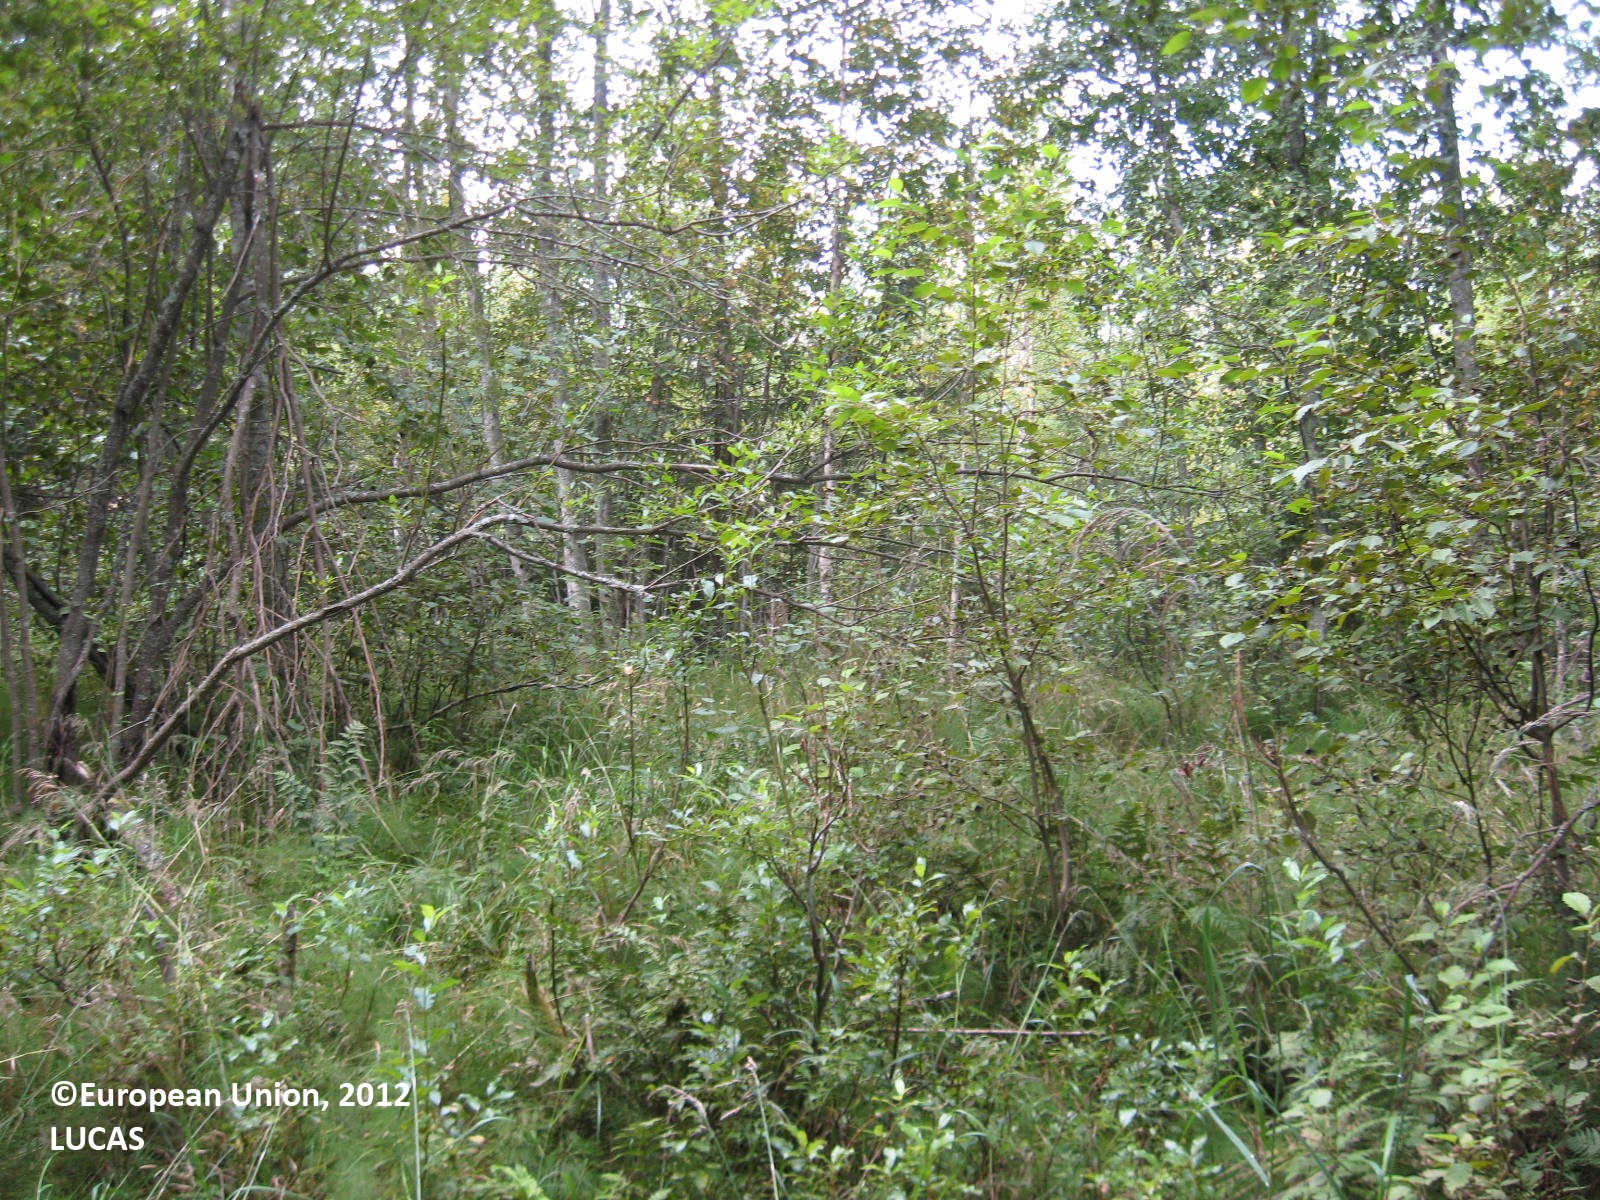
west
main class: Woodland
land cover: Broadleaved woodland
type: boreal forest
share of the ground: 50 - 75 %
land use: Forestry
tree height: > 5 m
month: August
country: FI
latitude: 63.4168
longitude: 29.6010
